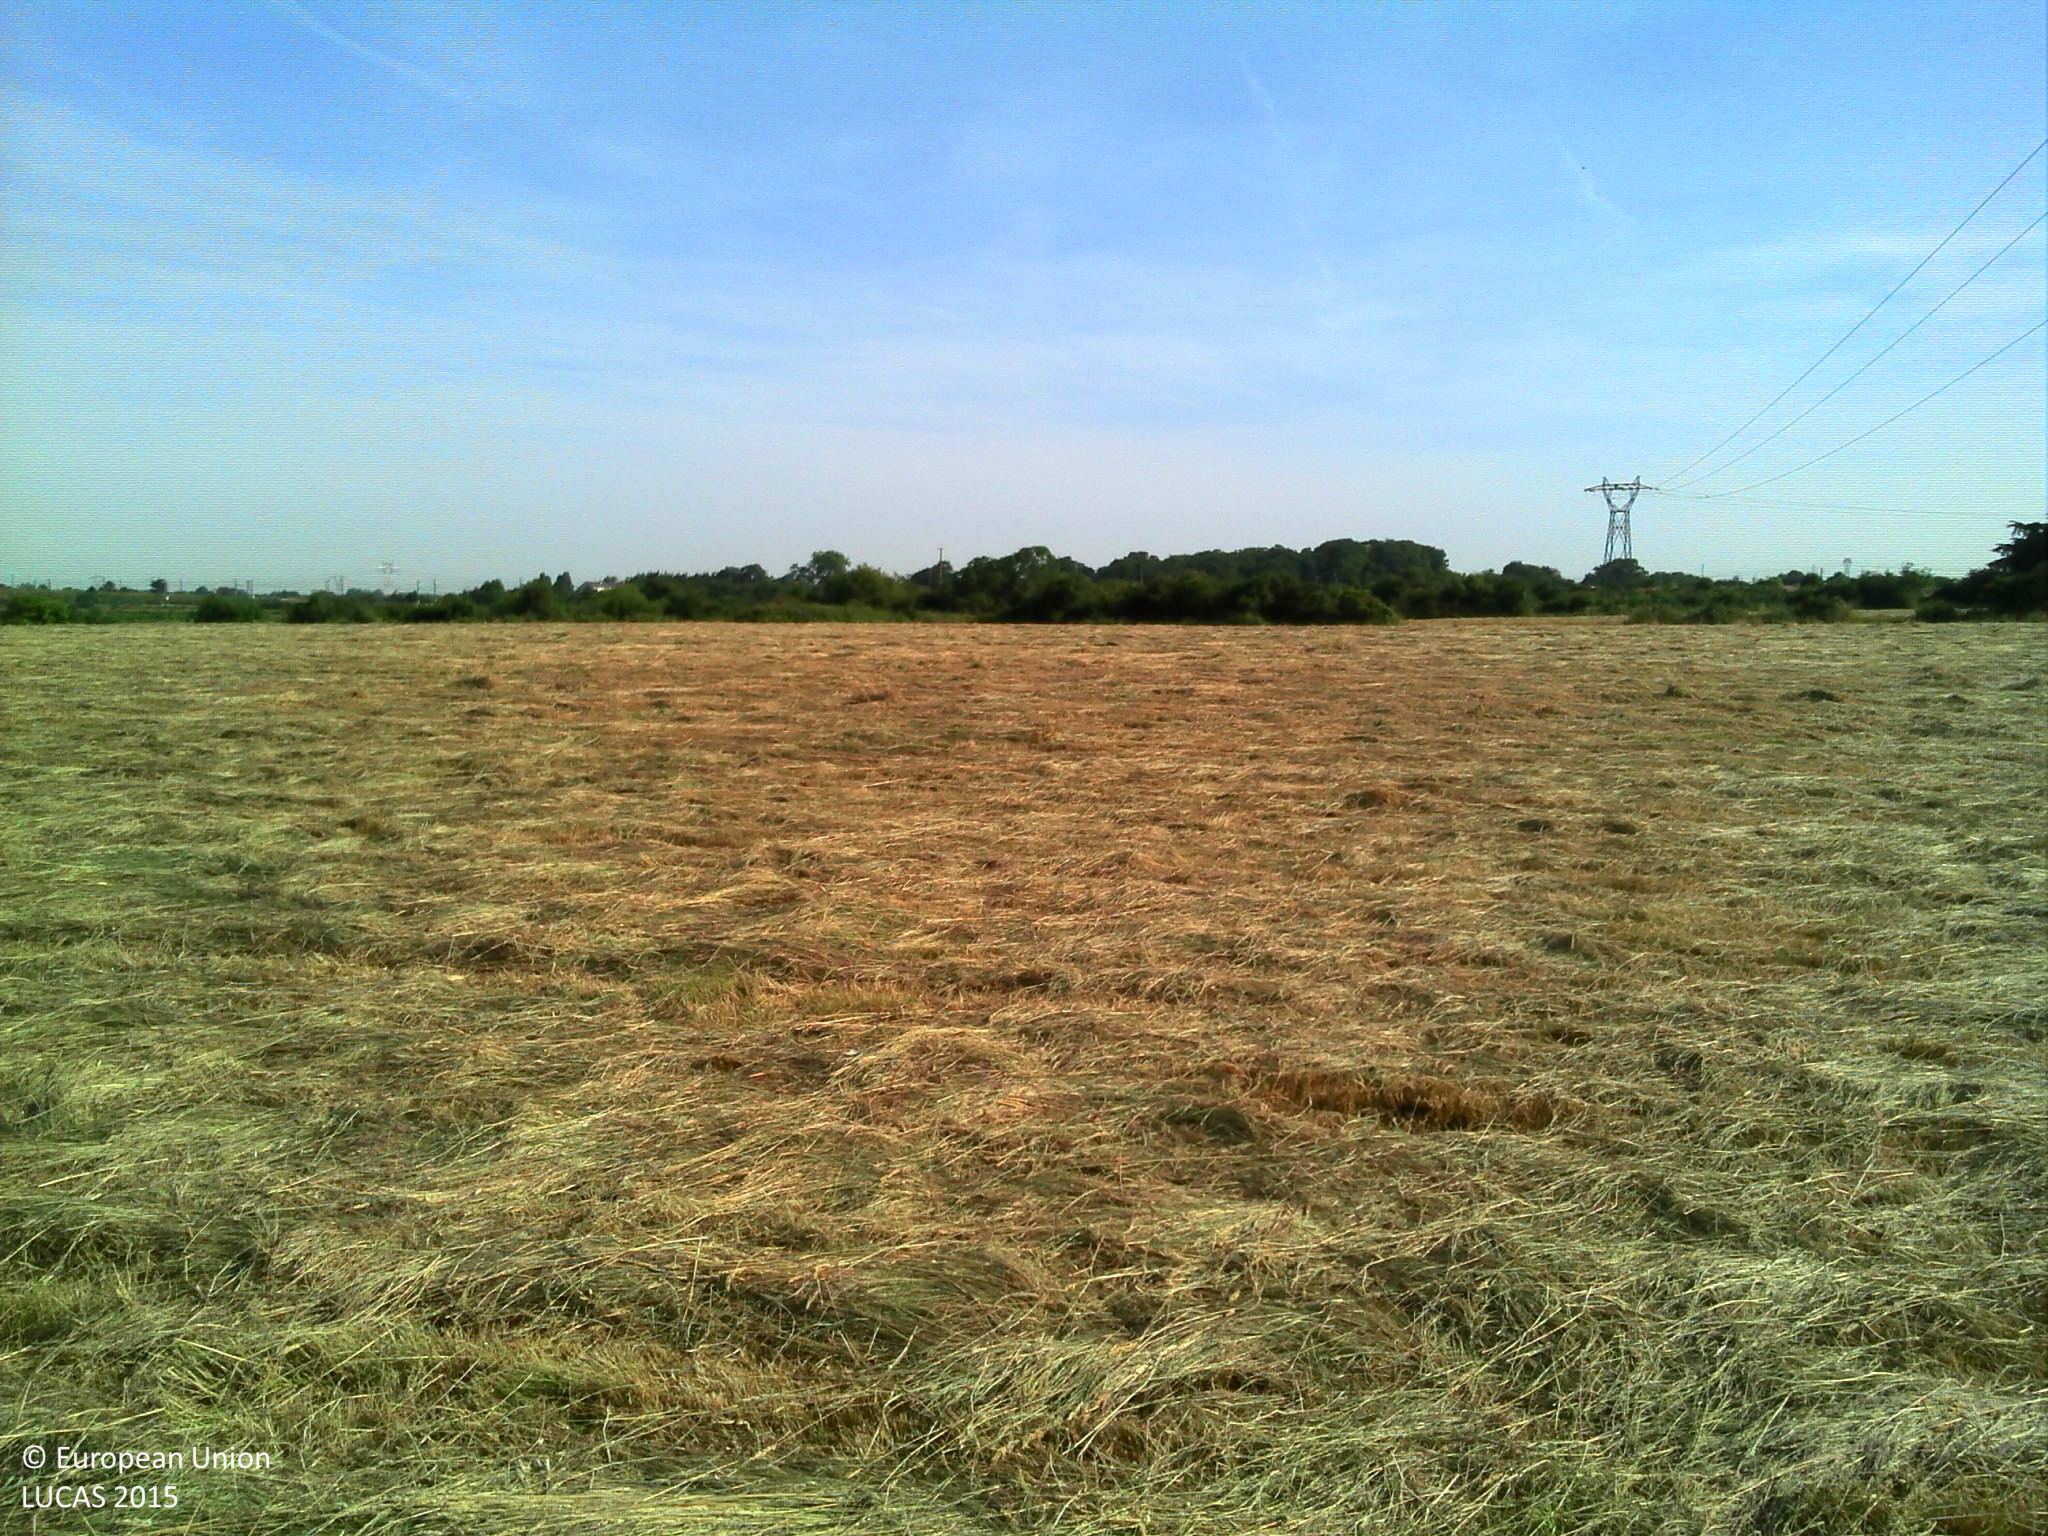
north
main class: Cropland
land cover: Temporary grasslands
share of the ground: > 75 %
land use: Agriculture (excluding fallow land and kitchen gardens)
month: June
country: FR
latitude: 47.3174
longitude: -2.1022
